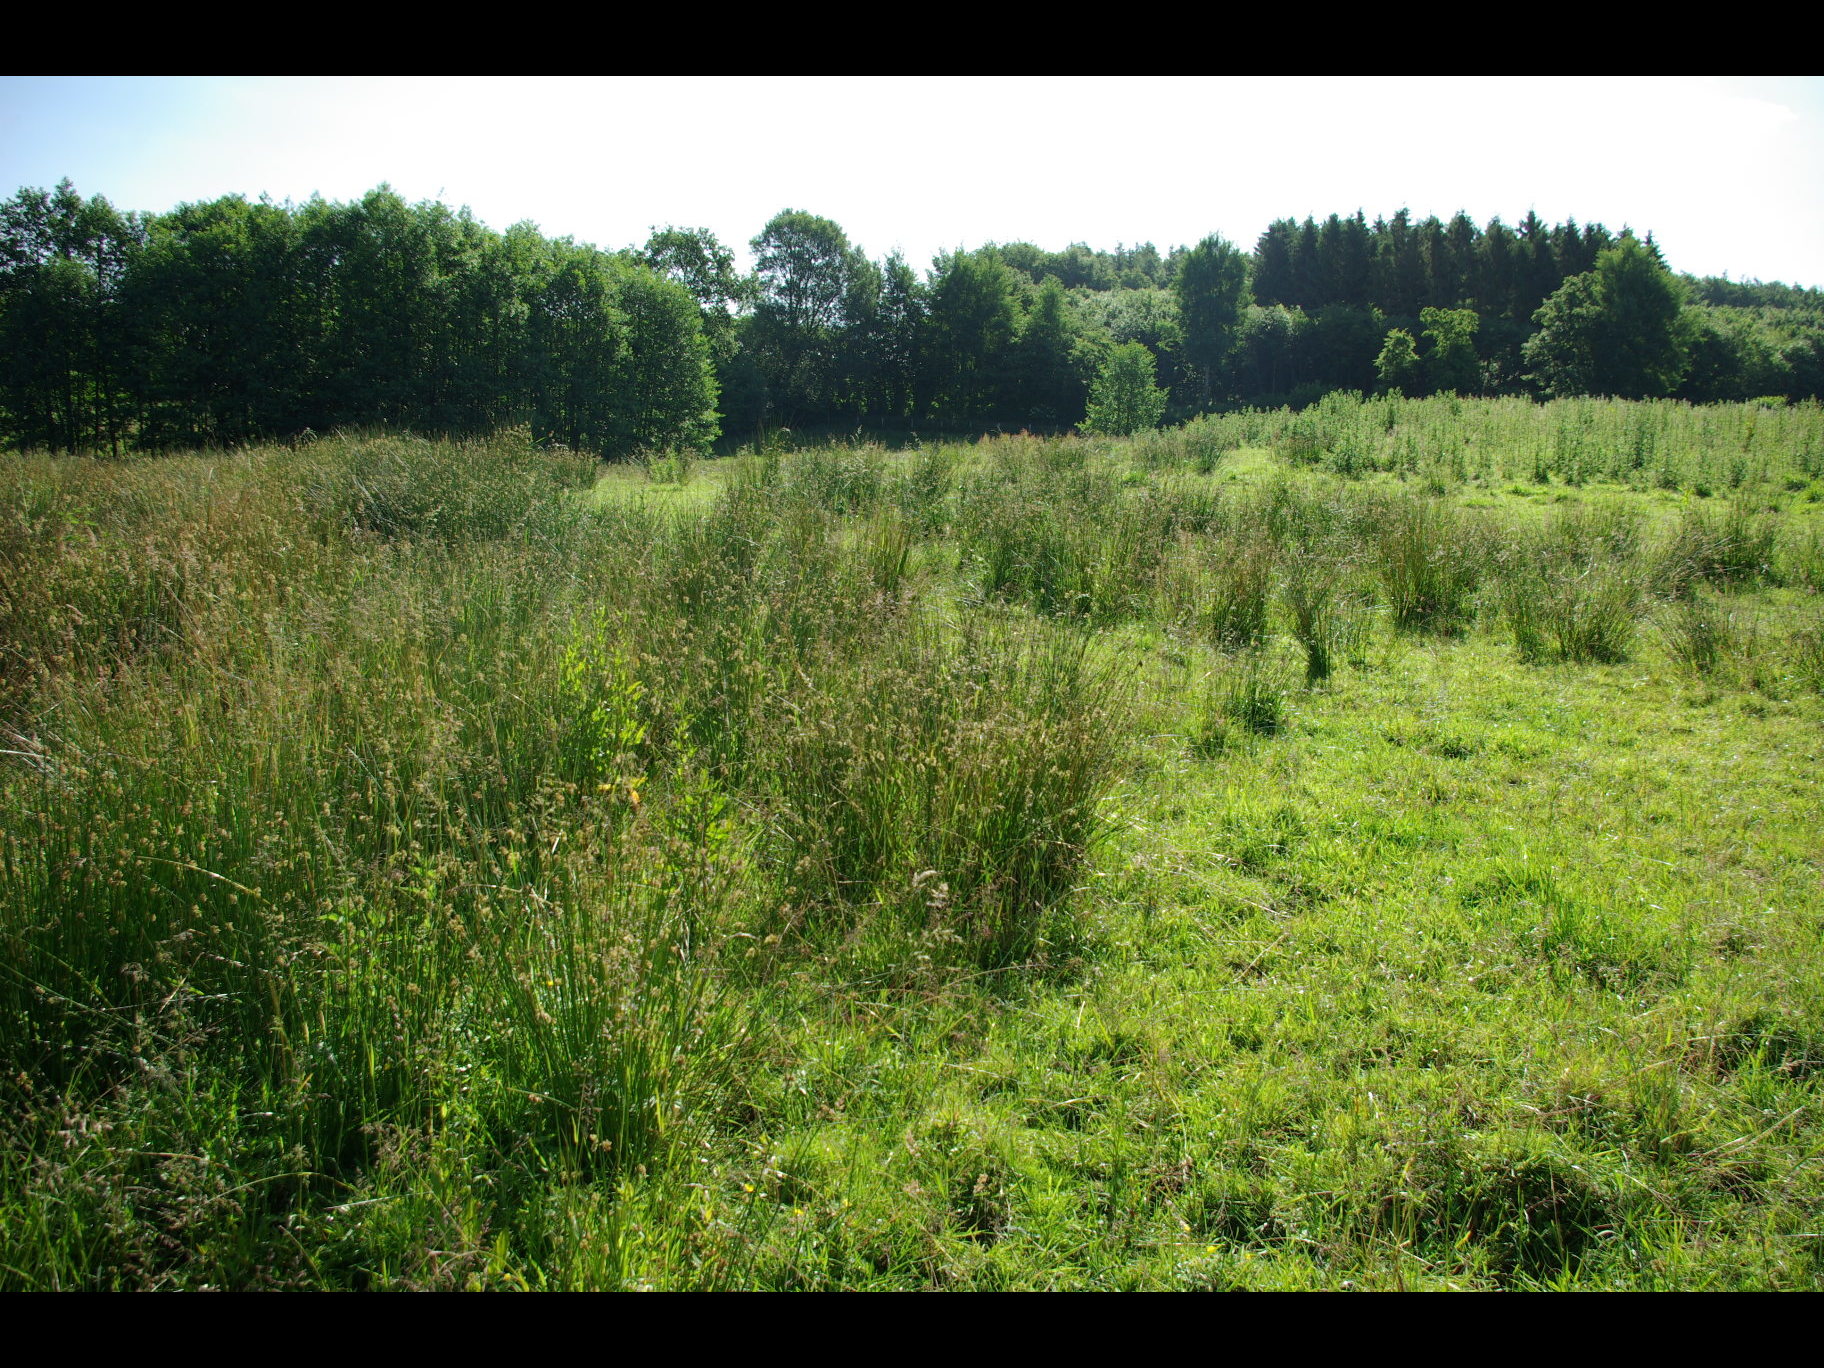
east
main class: Grassland
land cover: Grassland without tree/shrub cover
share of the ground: > 75 %
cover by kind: herbaceous plants 100 %
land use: Agriculture (excluding fallow land and kitchen gardens)
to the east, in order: Grassland without tree/shrub cover; Inland marshes; Grassland without tree/shrub cover; Fences; Grass margins; Paved roads, cycling and walking lanes; Grass margins; Broadleaved woodland; Spontaneously vegetated surfaces; Temporary grasslands; Spontaneously vegetated surfaces; Temporary grasslands
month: June
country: DE
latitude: 54.2645
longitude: 9.9233
